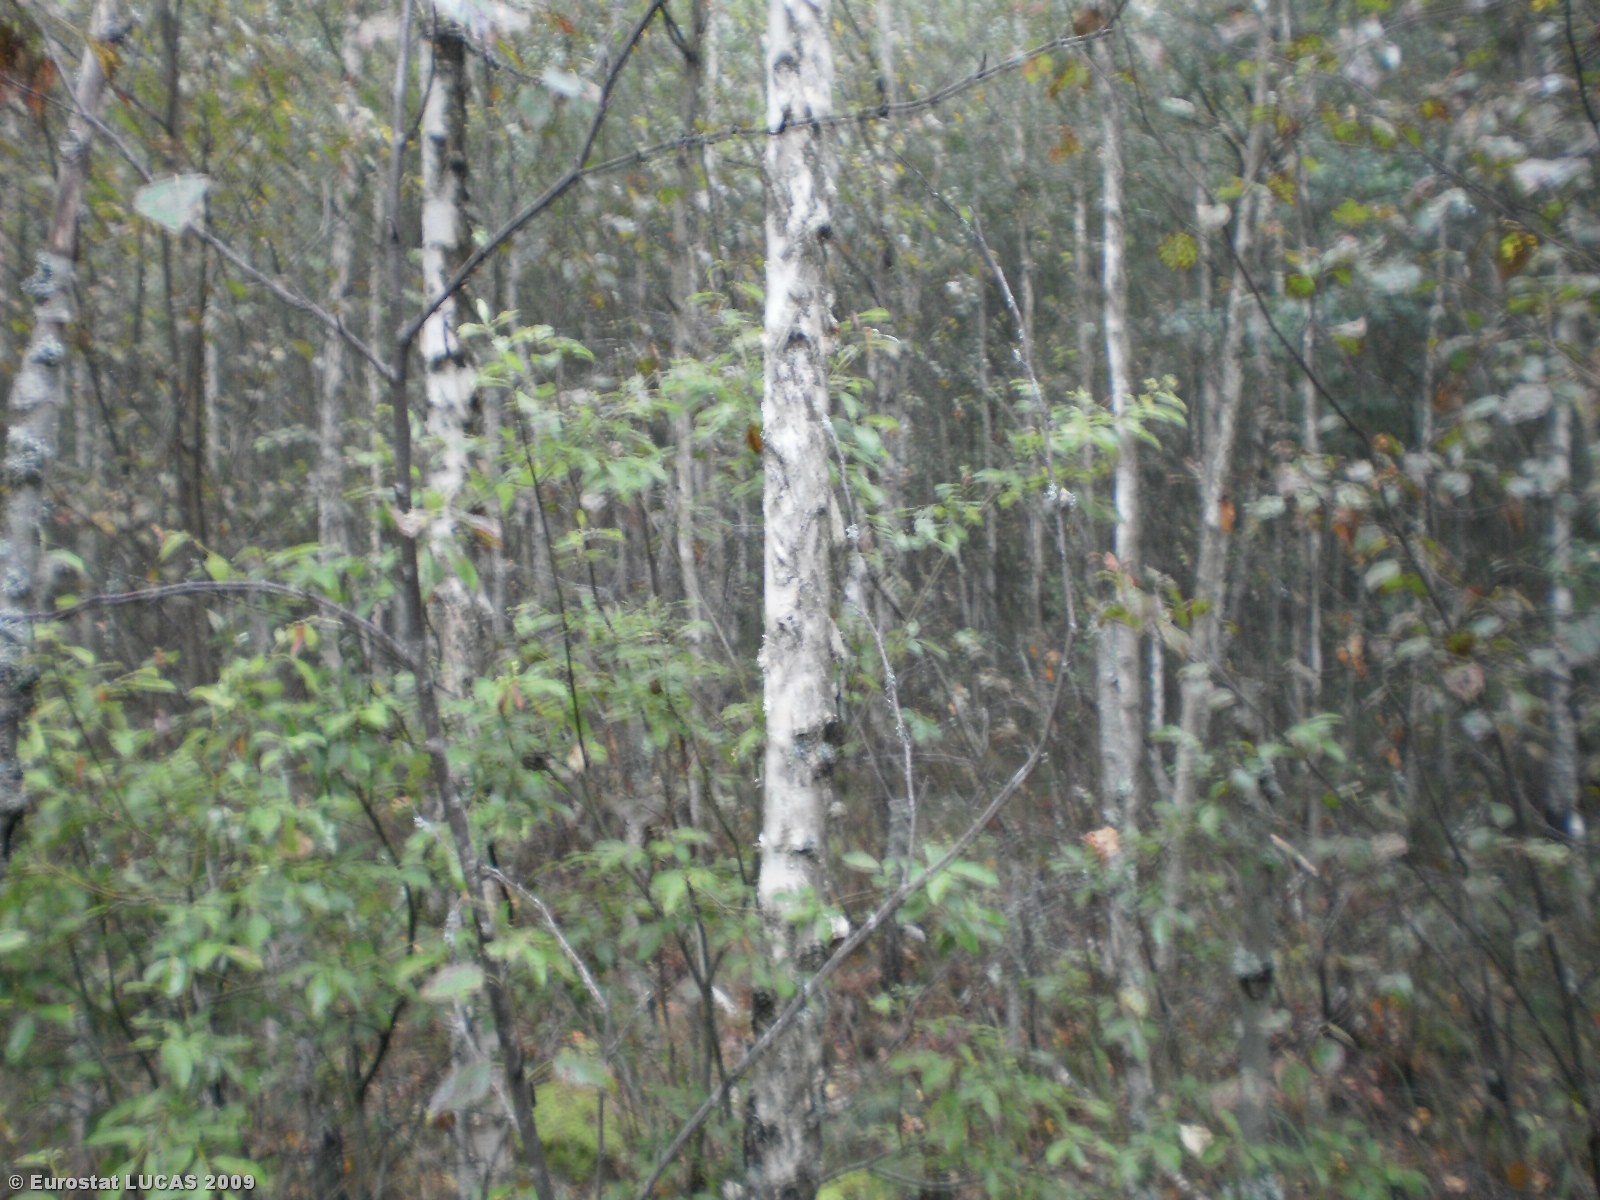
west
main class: Woodland
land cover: Broadleaved woodland
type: mire and swamp forests
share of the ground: > 75 %
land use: Forestry
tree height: > 5 m
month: August
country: LT
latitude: 55.3670
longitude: 25.6378
